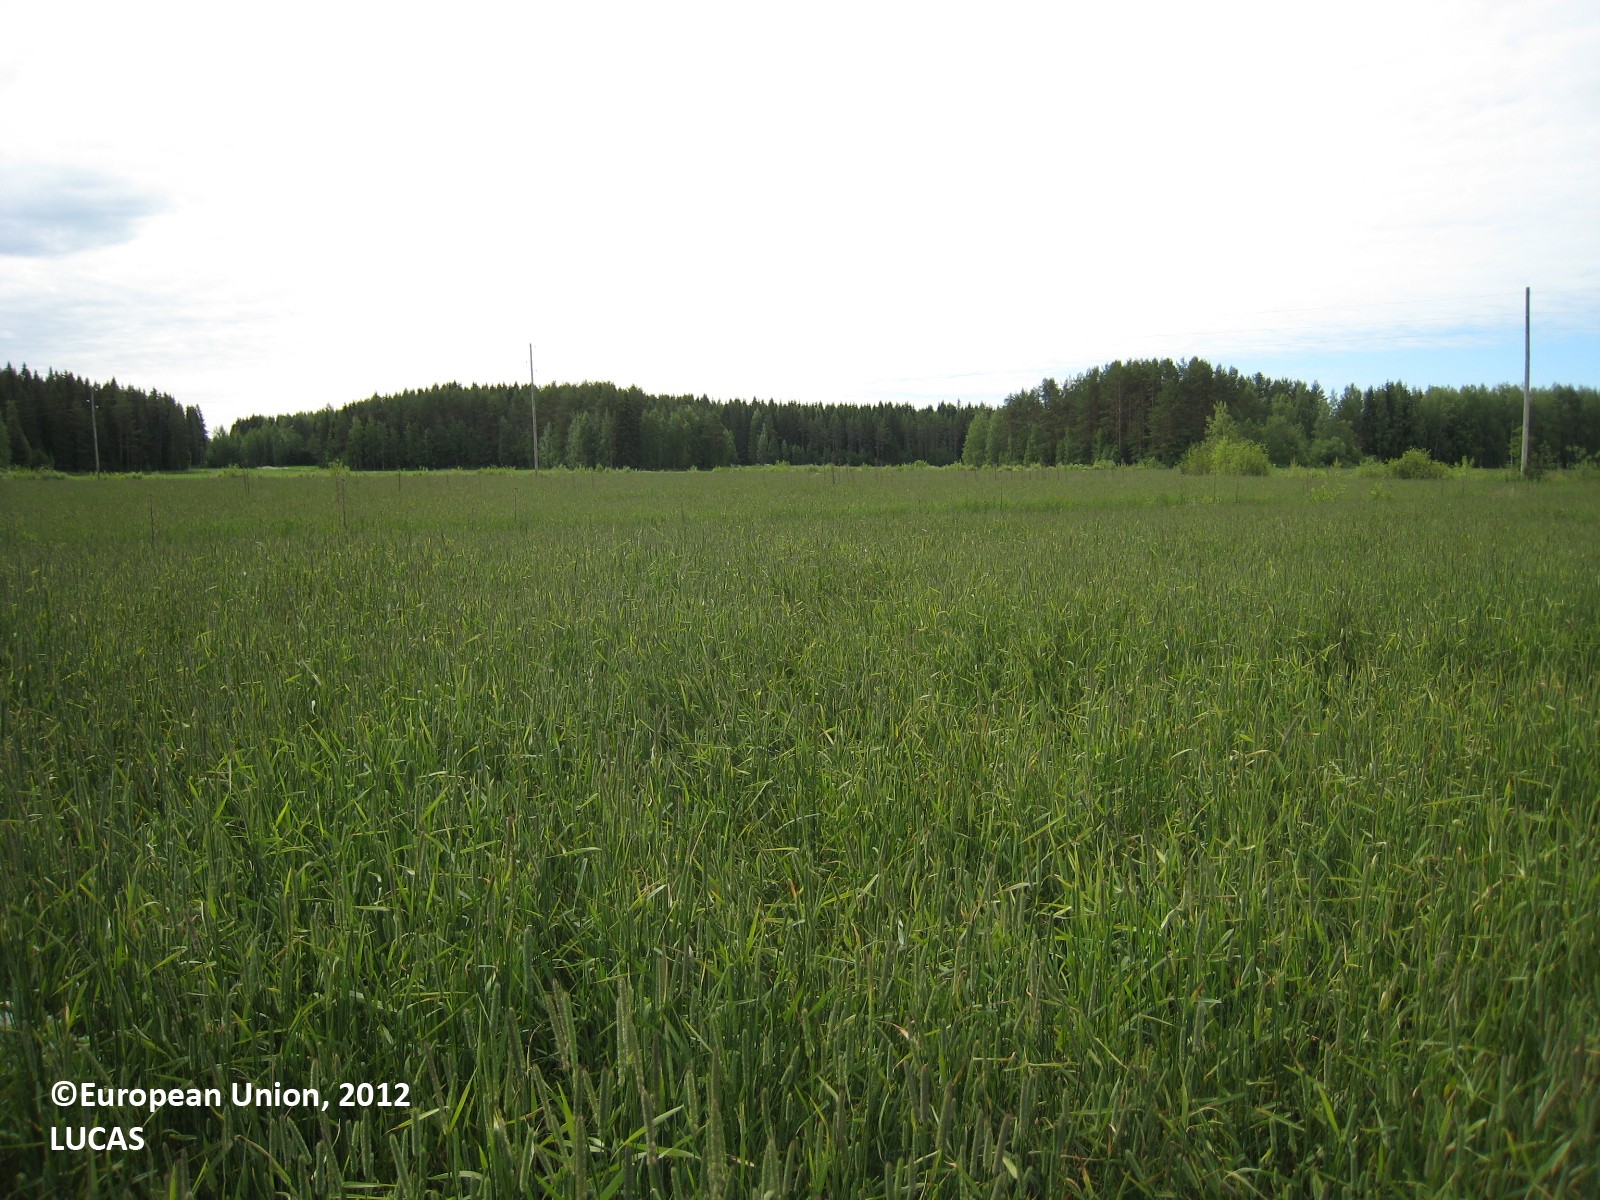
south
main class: Cropland
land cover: Temporary grasslands
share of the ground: > 75 %
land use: Agriculture (excluding fallow land and kitchen gardens)
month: June
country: FI
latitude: 62.3960
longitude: 26.3258
